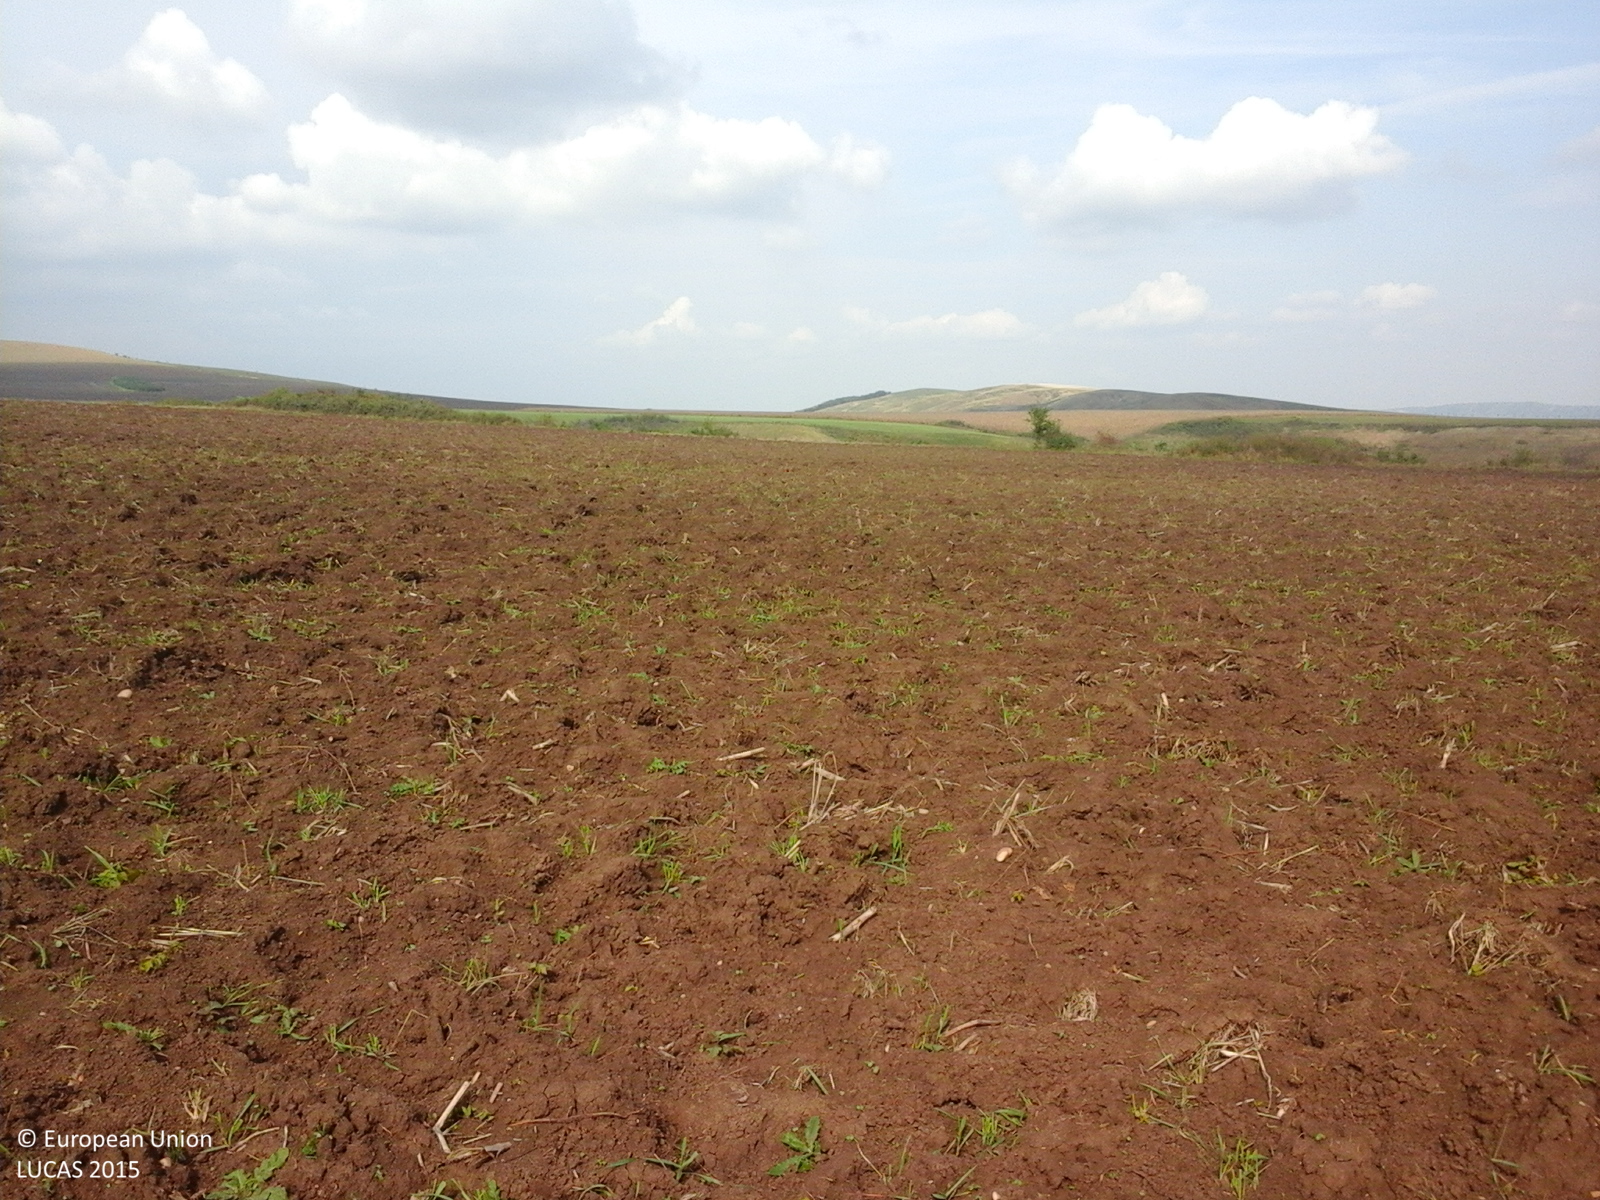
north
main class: Cropland
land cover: Maize
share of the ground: < 10 %
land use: Agriculture (excluding fallow land and kitchen gardens)
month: October
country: RO
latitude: 46.4447
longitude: 23.8855
